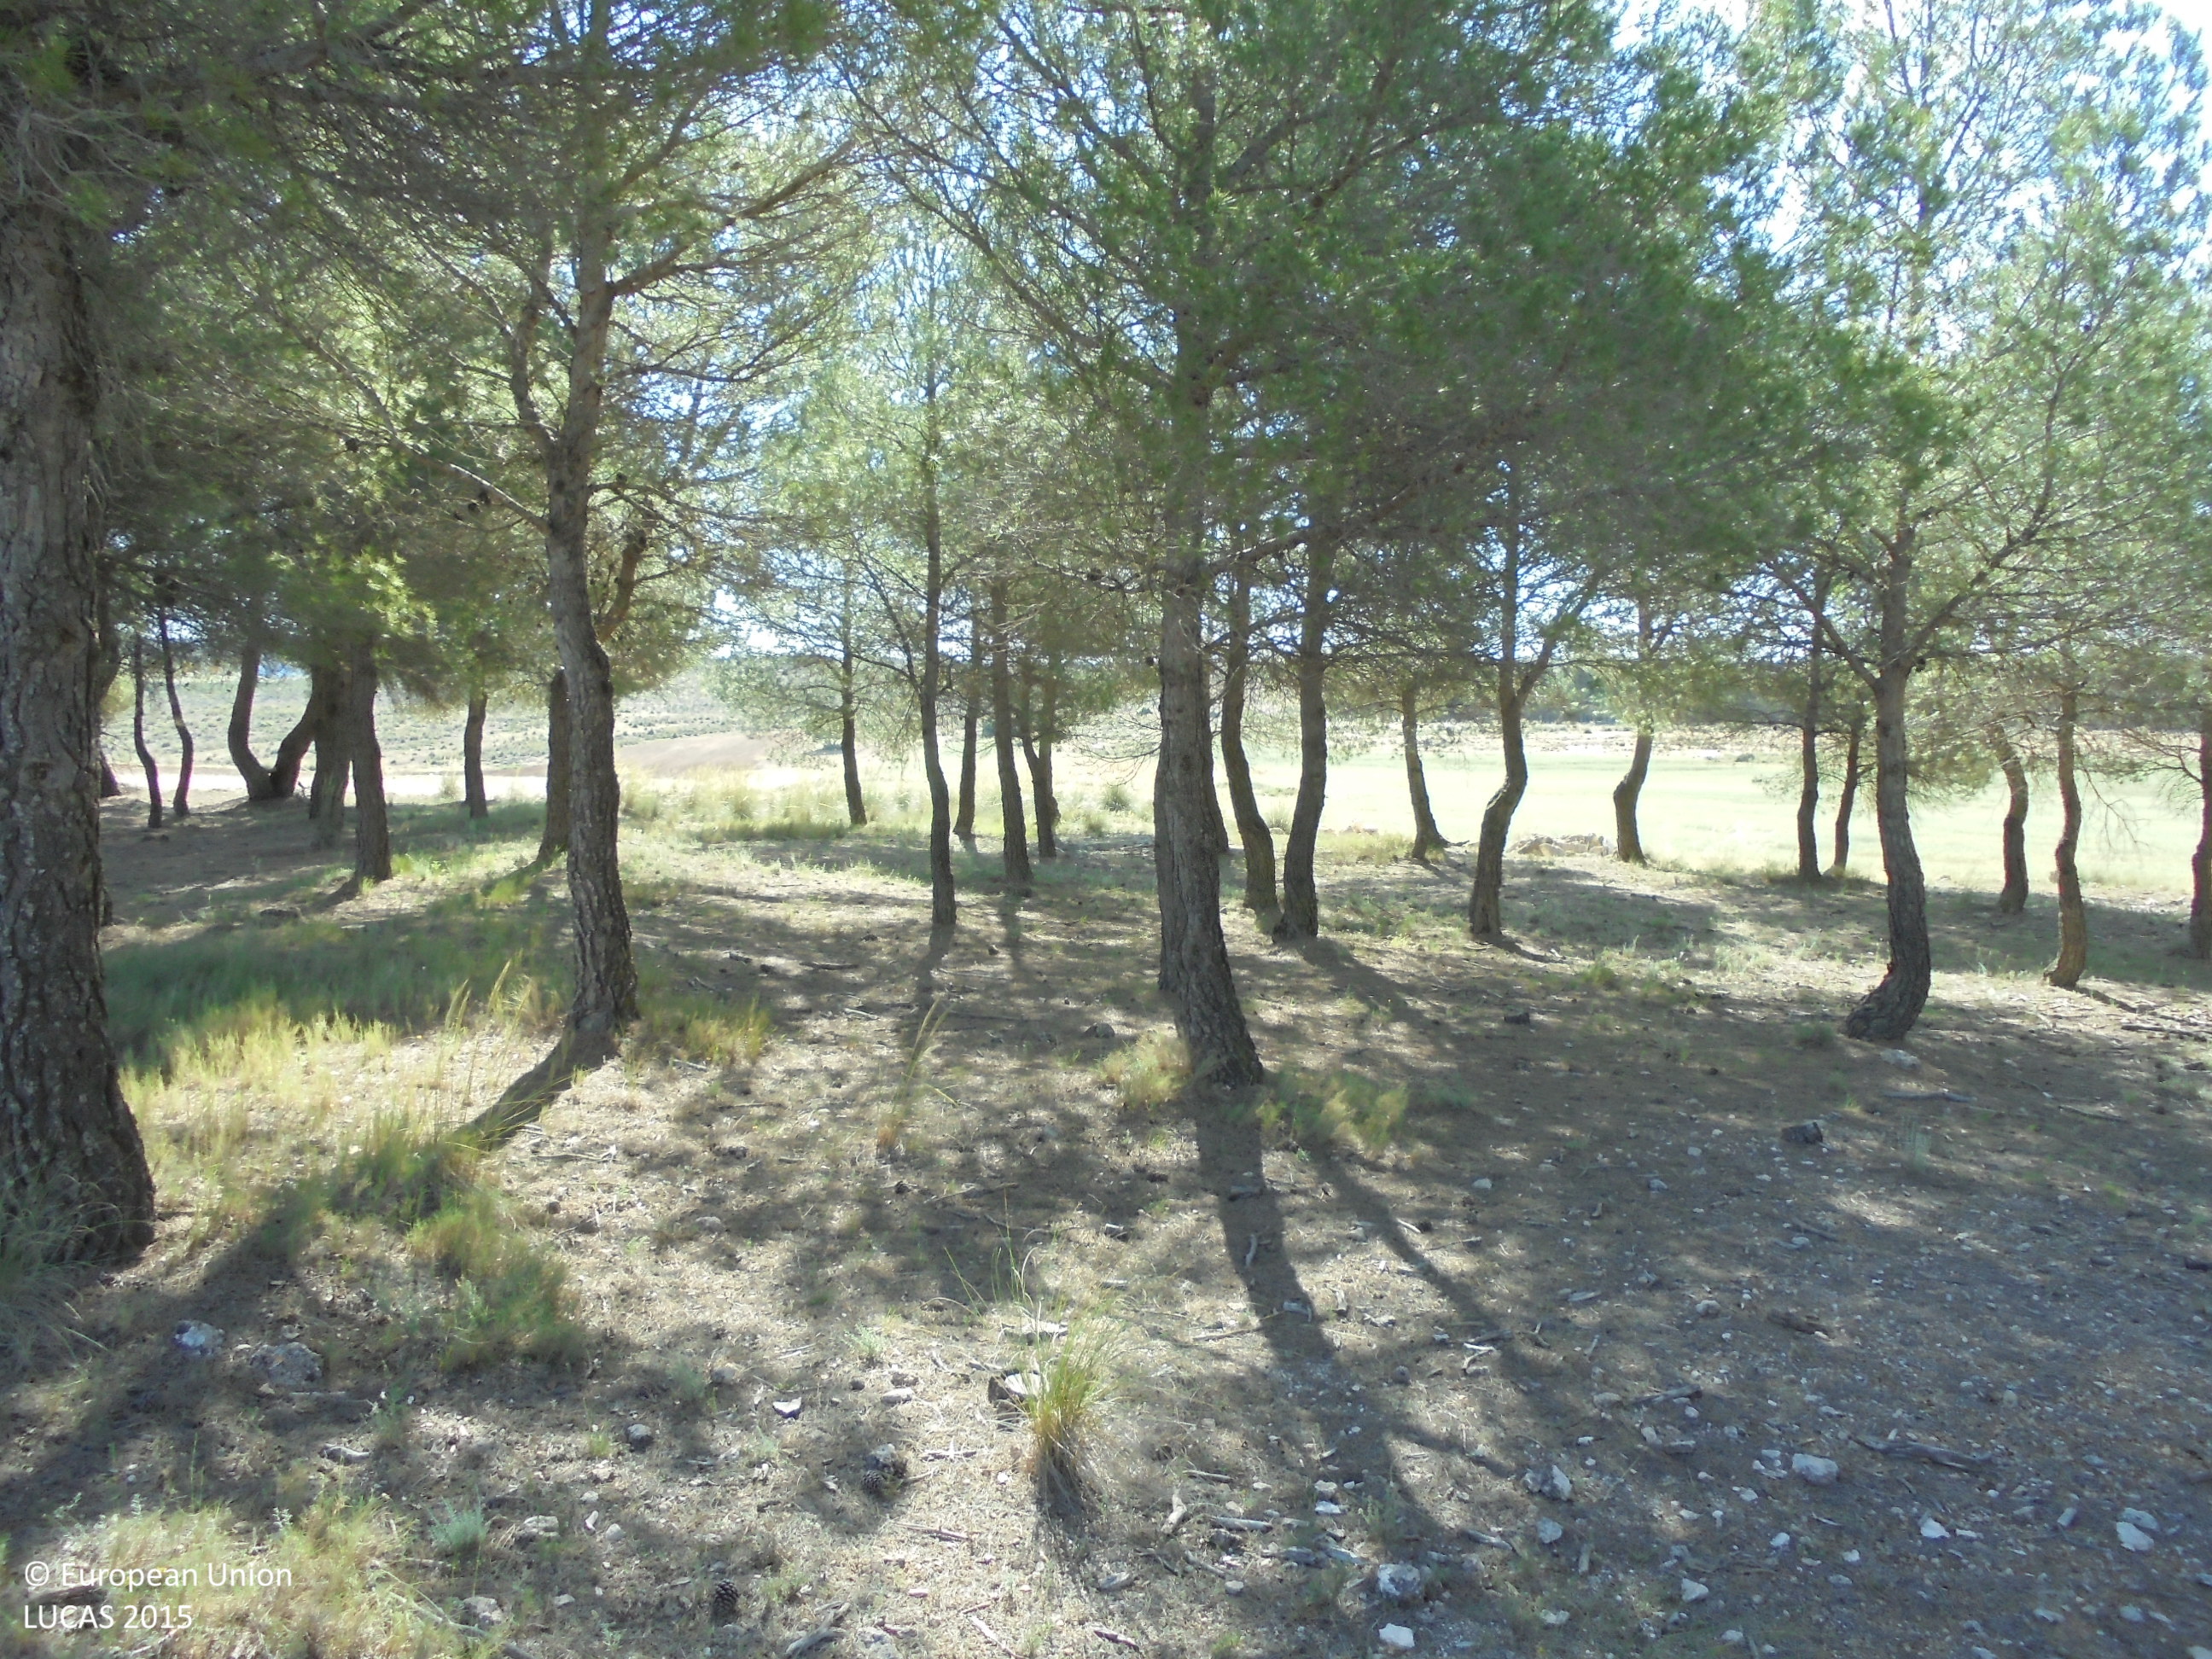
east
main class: Woodland
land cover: Pine dominated coniferous woodland
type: coniferous forest of the mediterranean region
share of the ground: > 75 %
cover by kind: coniferous forest trees 80 %, herbaceous plants 10 %, unconsolidated bare surface 10 %
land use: Semi-natural and natural areas not in use
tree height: > 5 m
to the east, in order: Pine dominated coniferous woodland; Shrubland without tree cover; Oats
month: May
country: ES
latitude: 38.9245
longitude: -1.7060
